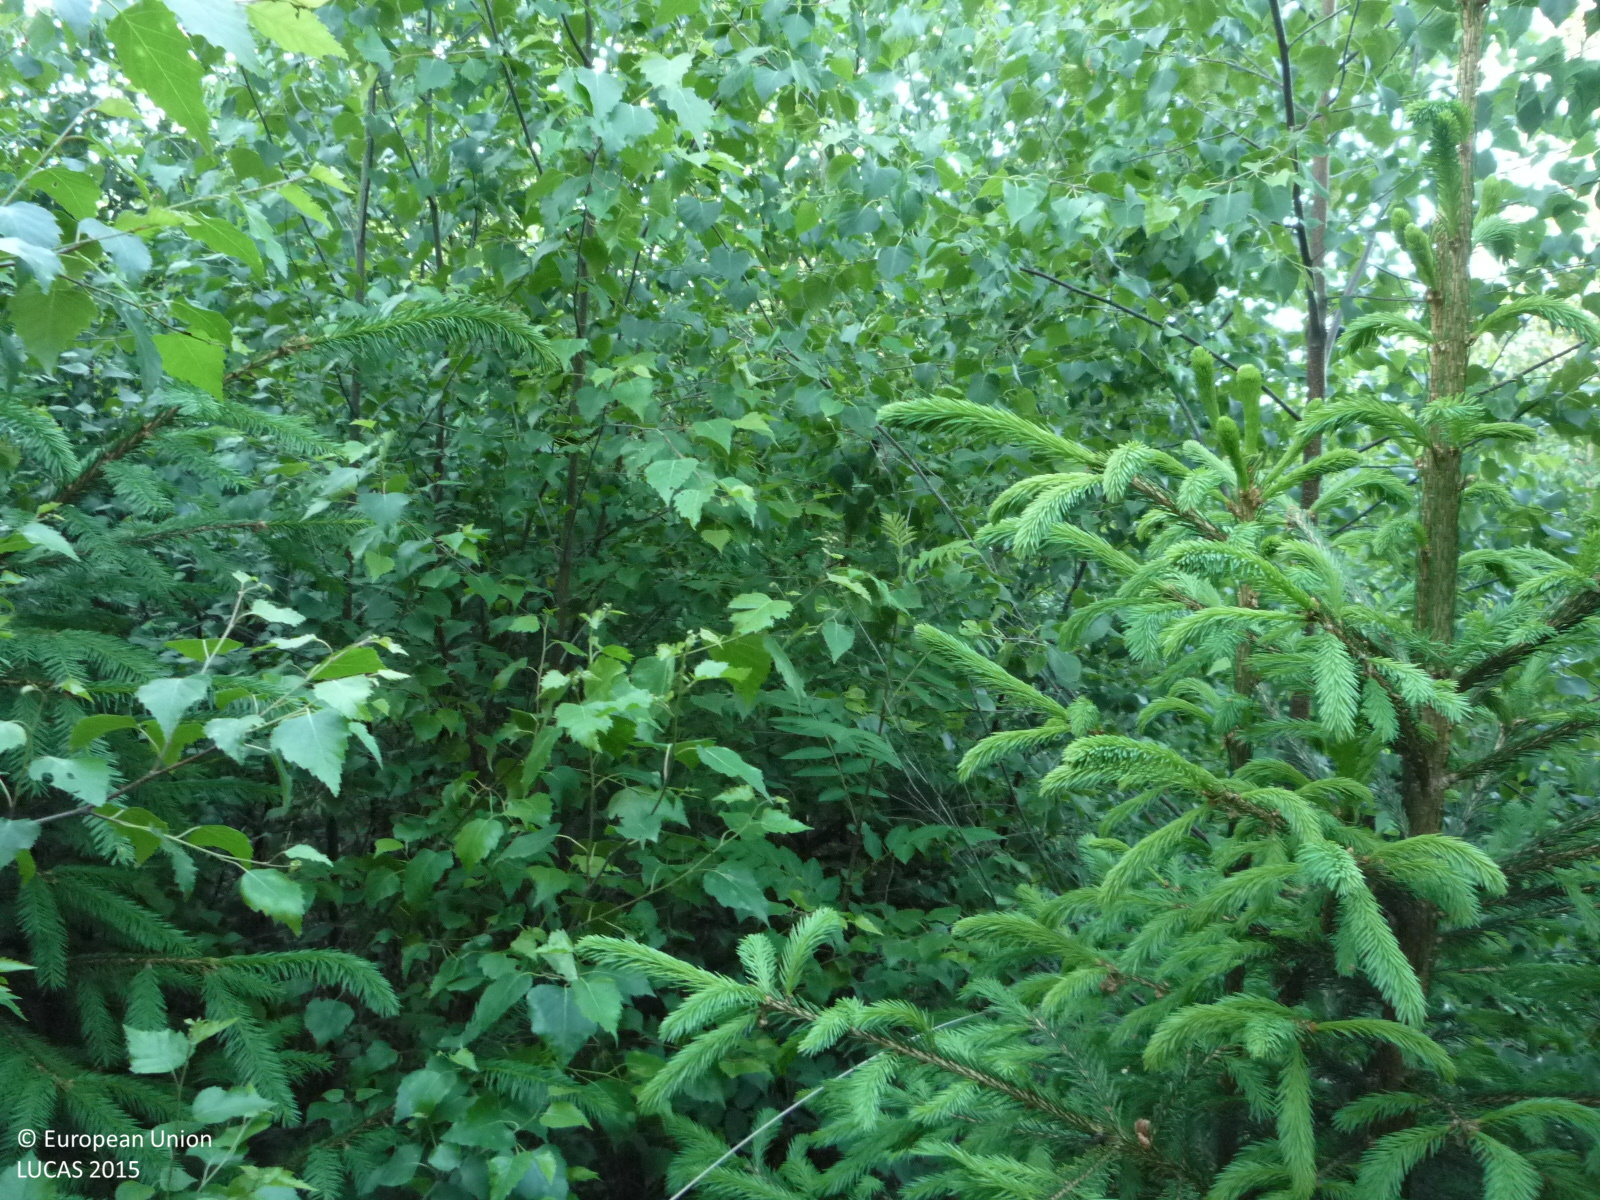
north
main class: Woodland
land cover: Spruce dominated mixed woodland
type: hemiboreal forest and nemoral coniferous forest and mixed broadleaved-coniferous forest
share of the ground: > 75 %
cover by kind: broadleaved forest trees 55 %, coniferous forest trees 30 %, shrubs 15 %
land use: Forestry
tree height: > 5 m
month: June
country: CZ
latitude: 49.7806
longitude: 15.1275
